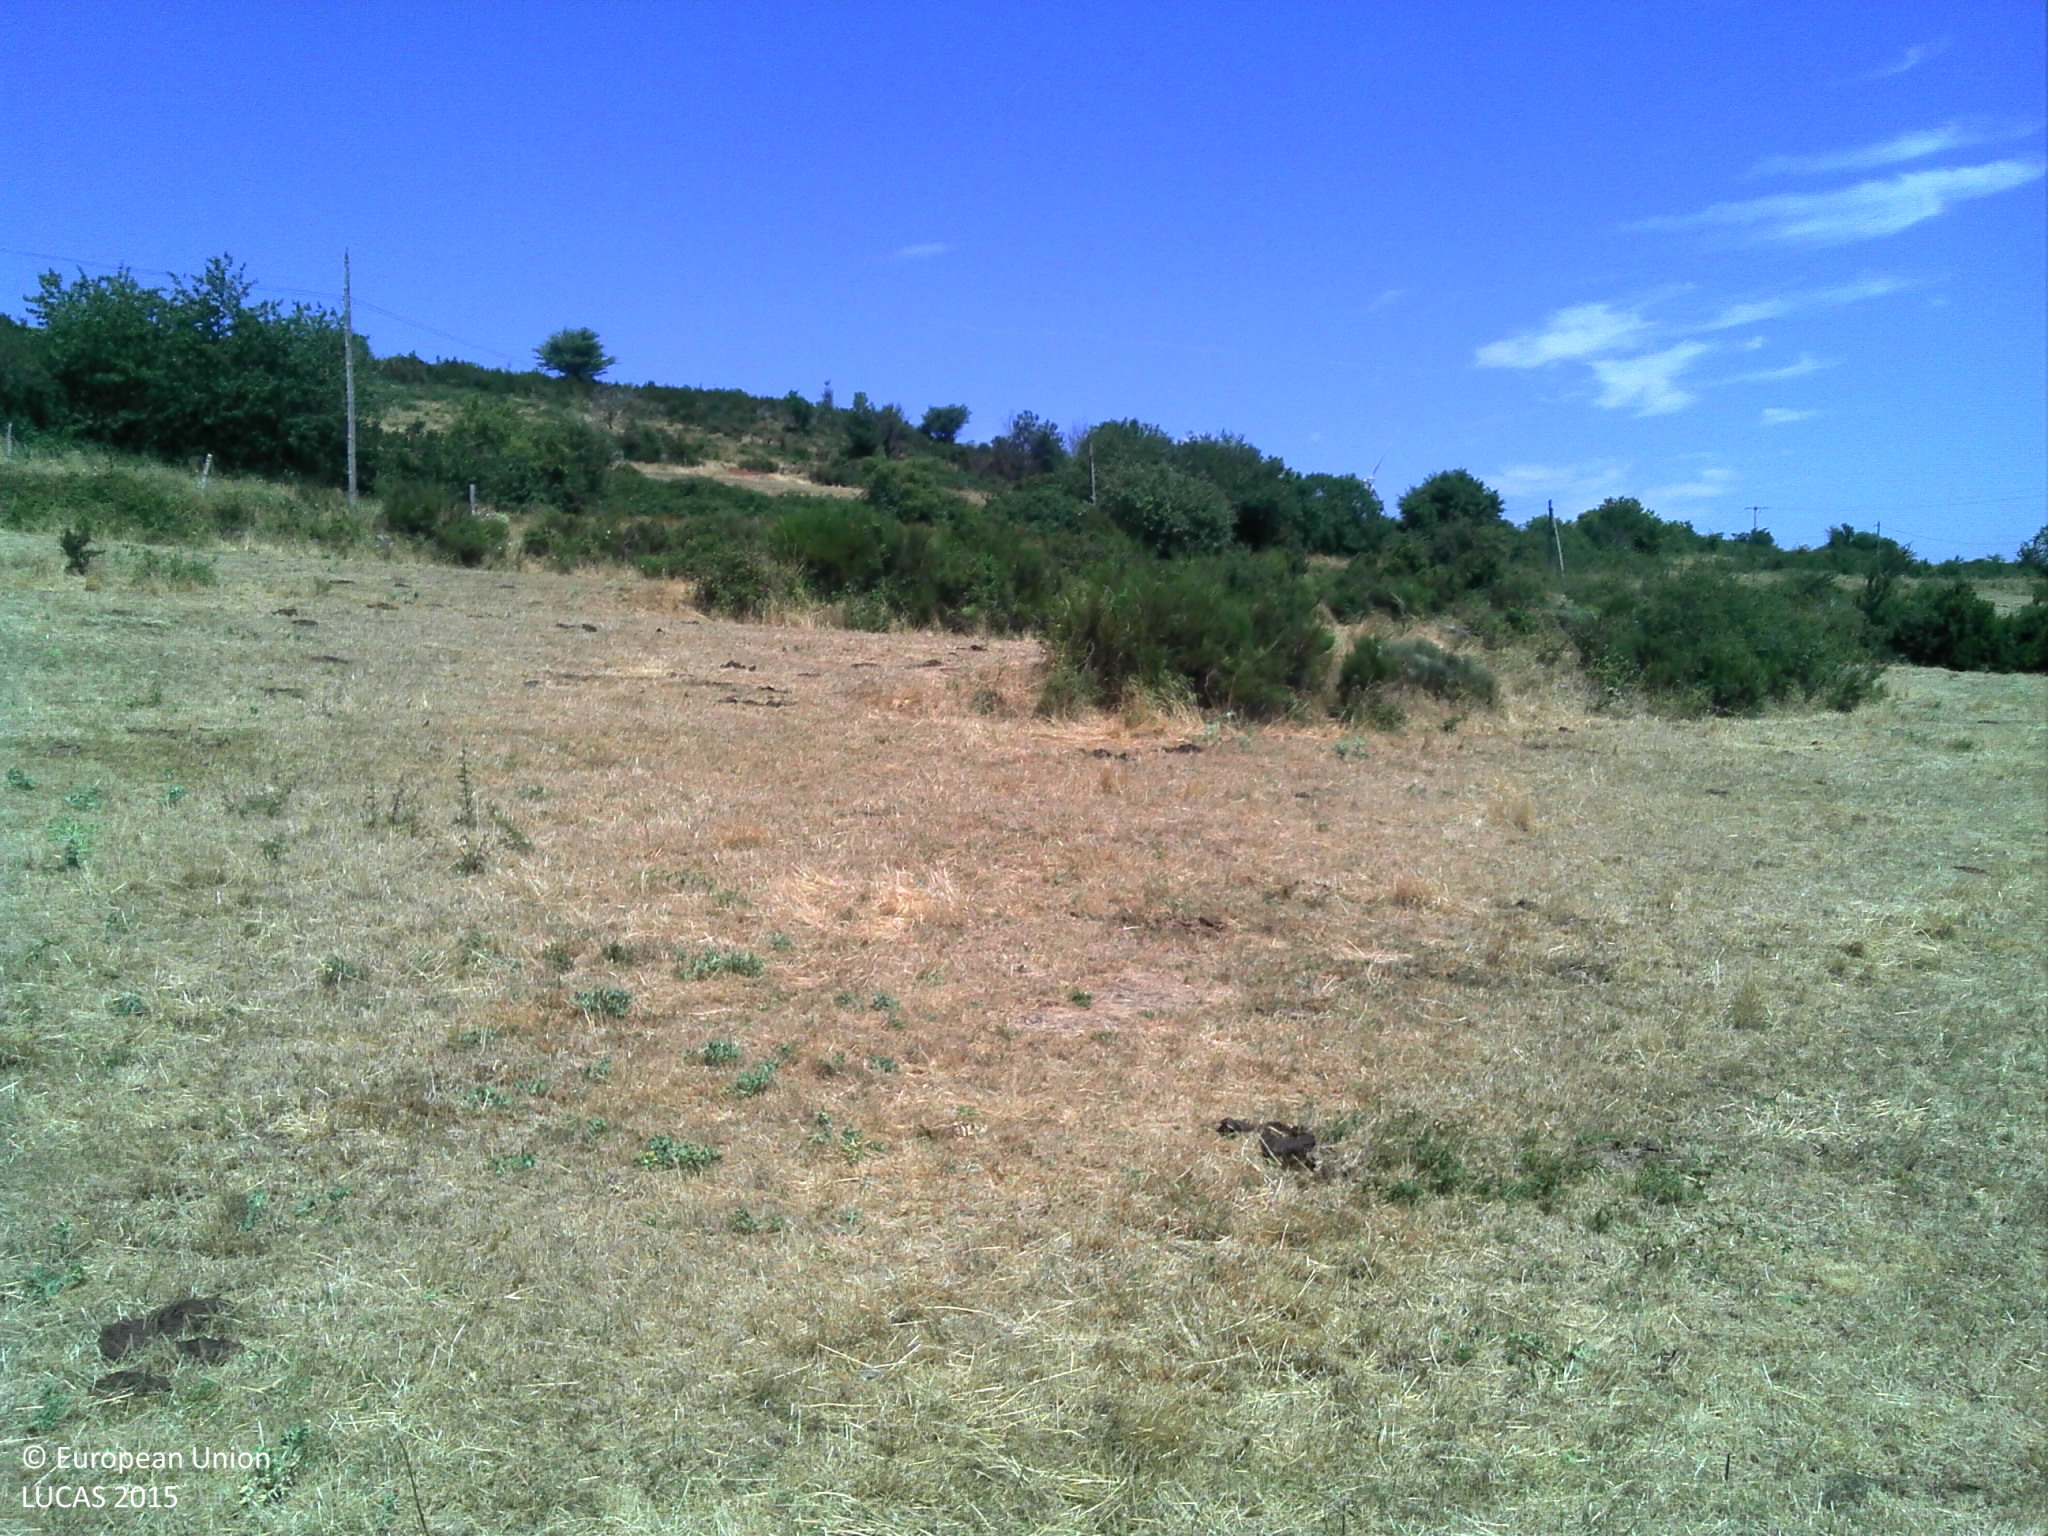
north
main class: Grassland
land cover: Grassland with sparse tree/shrub cover
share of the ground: > 75 %
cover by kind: herbaceous plants 95 %, broadleaved forest trees 5 %
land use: Agriculture (excluding fallow land and kitchen gardens)
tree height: < 5 m
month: July
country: FR
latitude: 44.6782
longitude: 4.5689
